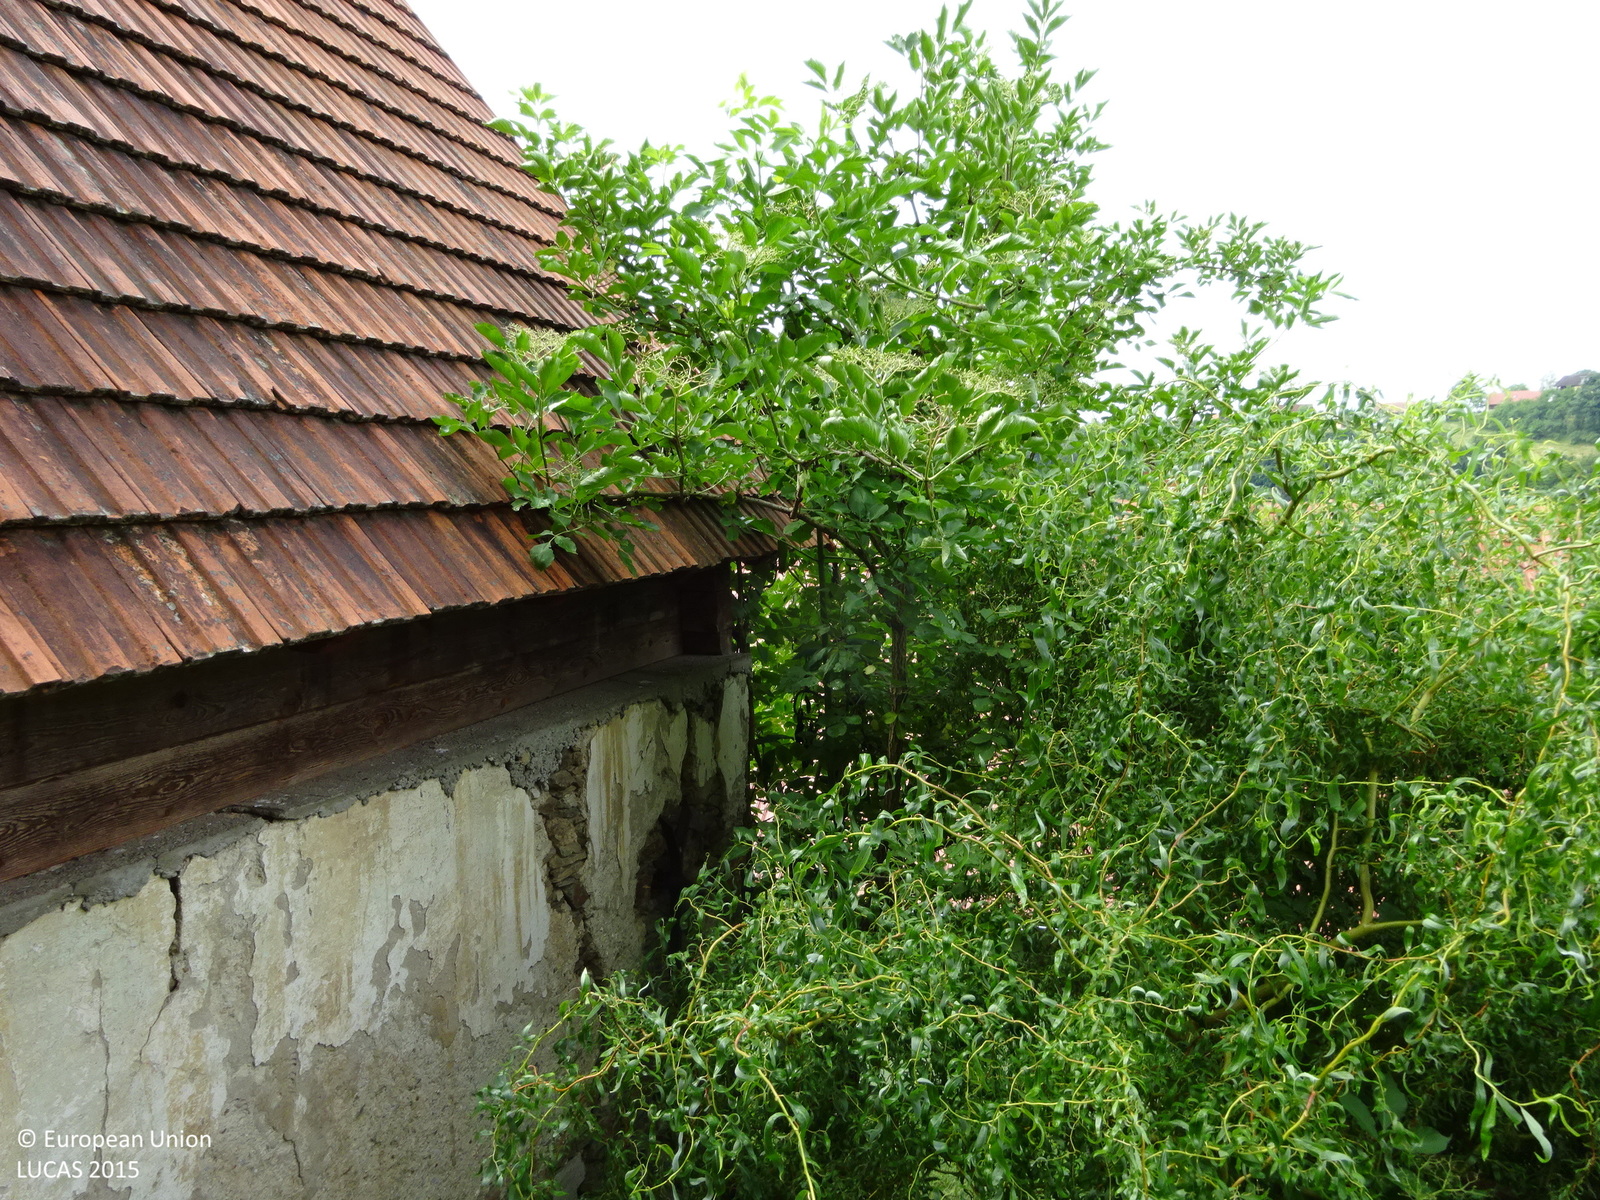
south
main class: Cropland
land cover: Apple fruit
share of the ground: 25 - 50 %
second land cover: Grassland without tree/shrub cover
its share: > 75 %
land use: Kitchen garden
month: June
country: AT
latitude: 46.7726
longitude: 15.4339
